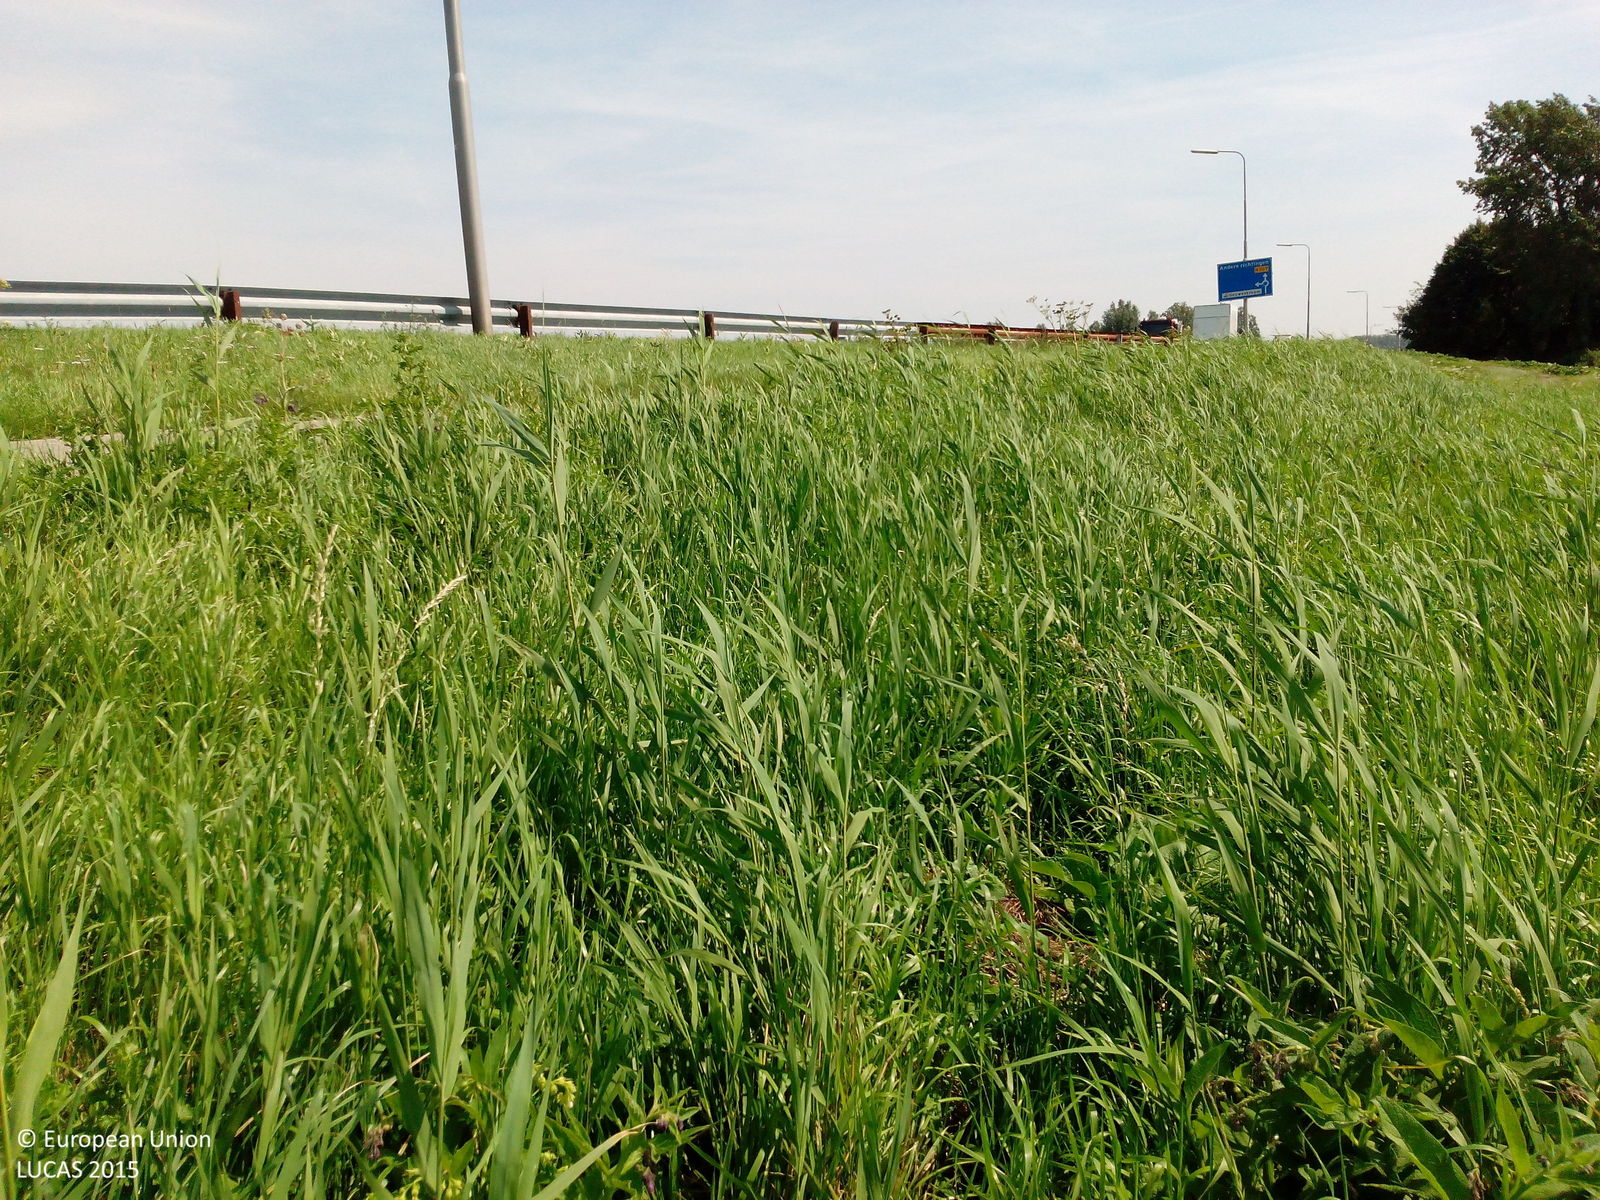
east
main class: Grassland
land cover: Grassland without tree/shrub cover
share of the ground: > 75 %
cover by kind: herbaceous plants 80 %, unconsolidated bare surface 20 %
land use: Agriculture (excluding fallow land and kitchen gardens)
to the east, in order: Grassland without tree/shrub cover; Inland fresh running water; Grassland without tree/shrub cover; Ditches and canals; Grassland without tree/shrub cover; Paved roads, cycling and walking lanes; Grassland without tree/shrub cover; Inland fresh running water; Grassland without tree/shrub cover; Inland fresh running water
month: August
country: NL
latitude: 52.0060
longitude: 4.6792
